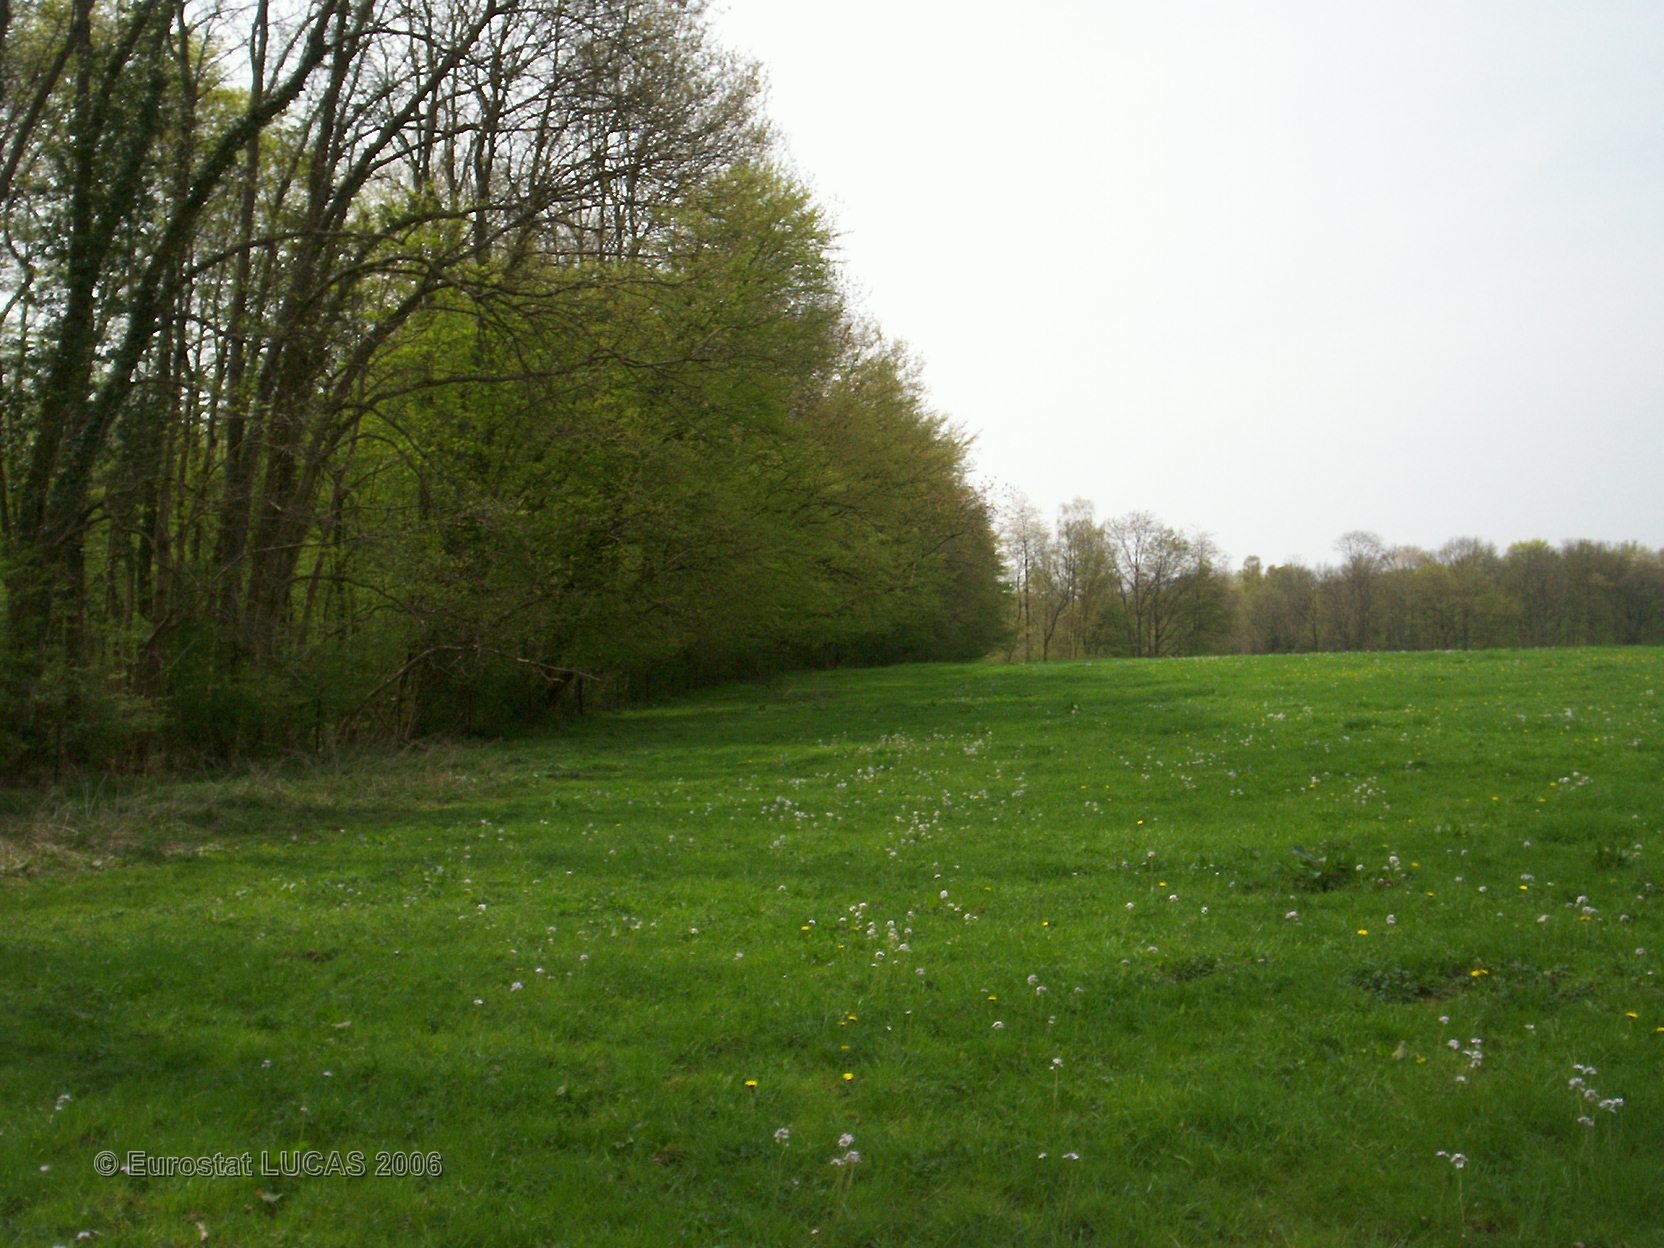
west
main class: Grassland
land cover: Grassland without tree/shrub cover
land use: Agriculture (excluding fallow land and kitchen gardens)
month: May
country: FR
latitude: 49.8824
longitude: 4.3592
